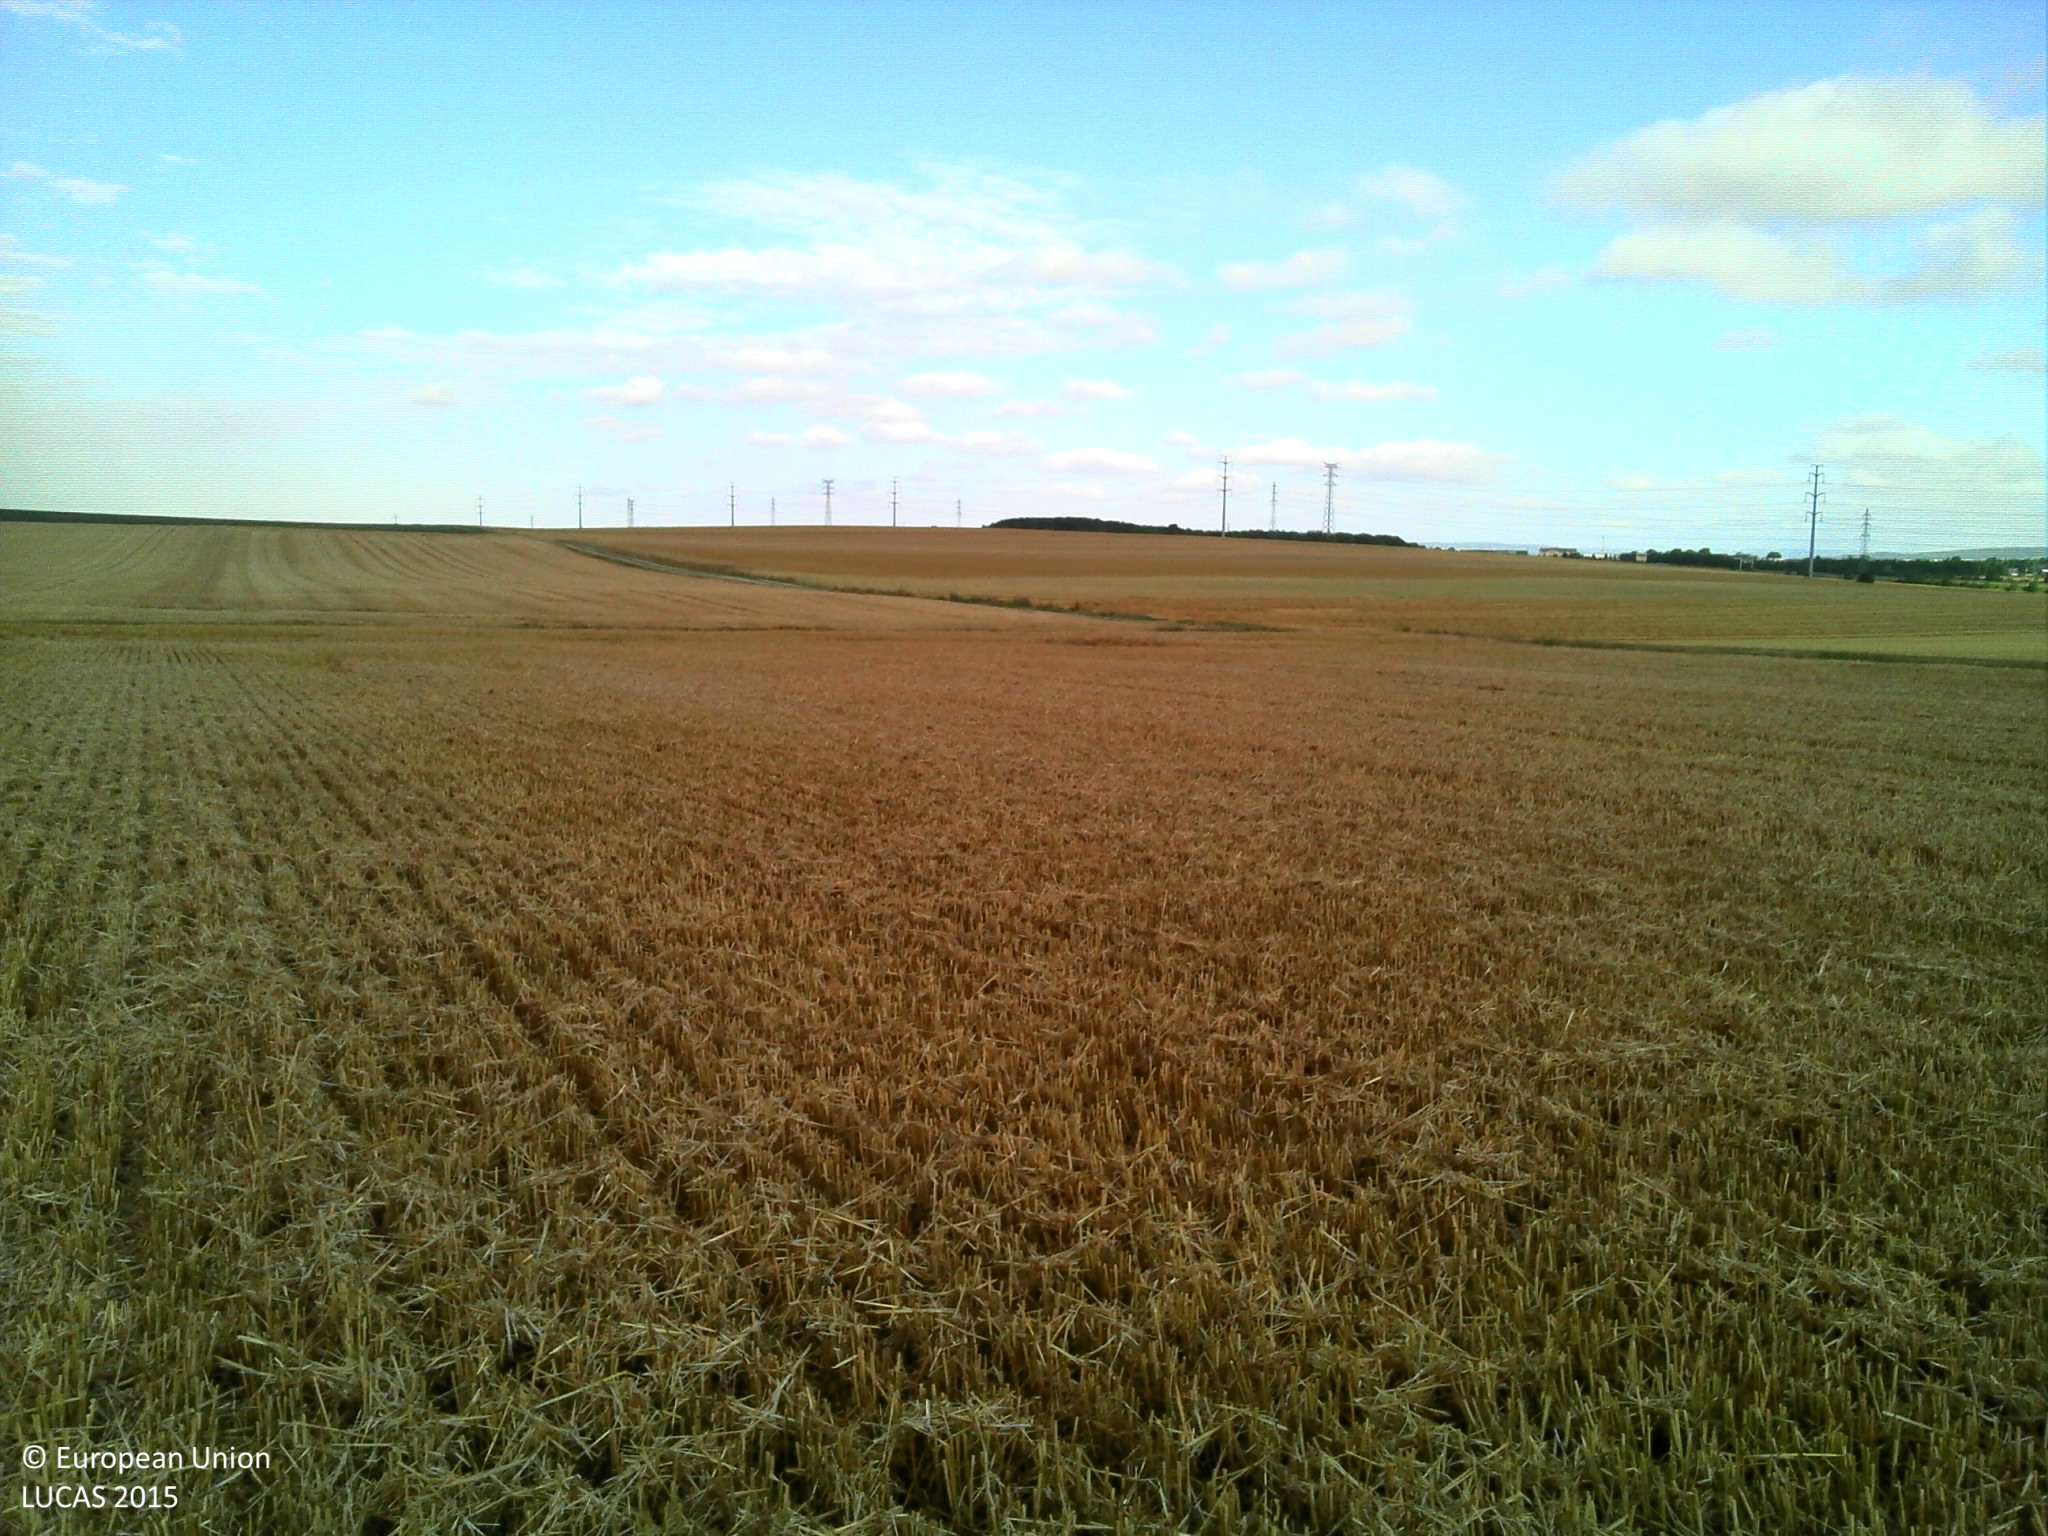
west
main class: Cropland
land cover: Common wheat
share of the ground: > 75 %
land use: Agriculture (excluding fallow land and kitchen gardens)
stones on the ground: < 10 %
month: July
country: FR
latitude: 49.2755
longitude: 4.1262
